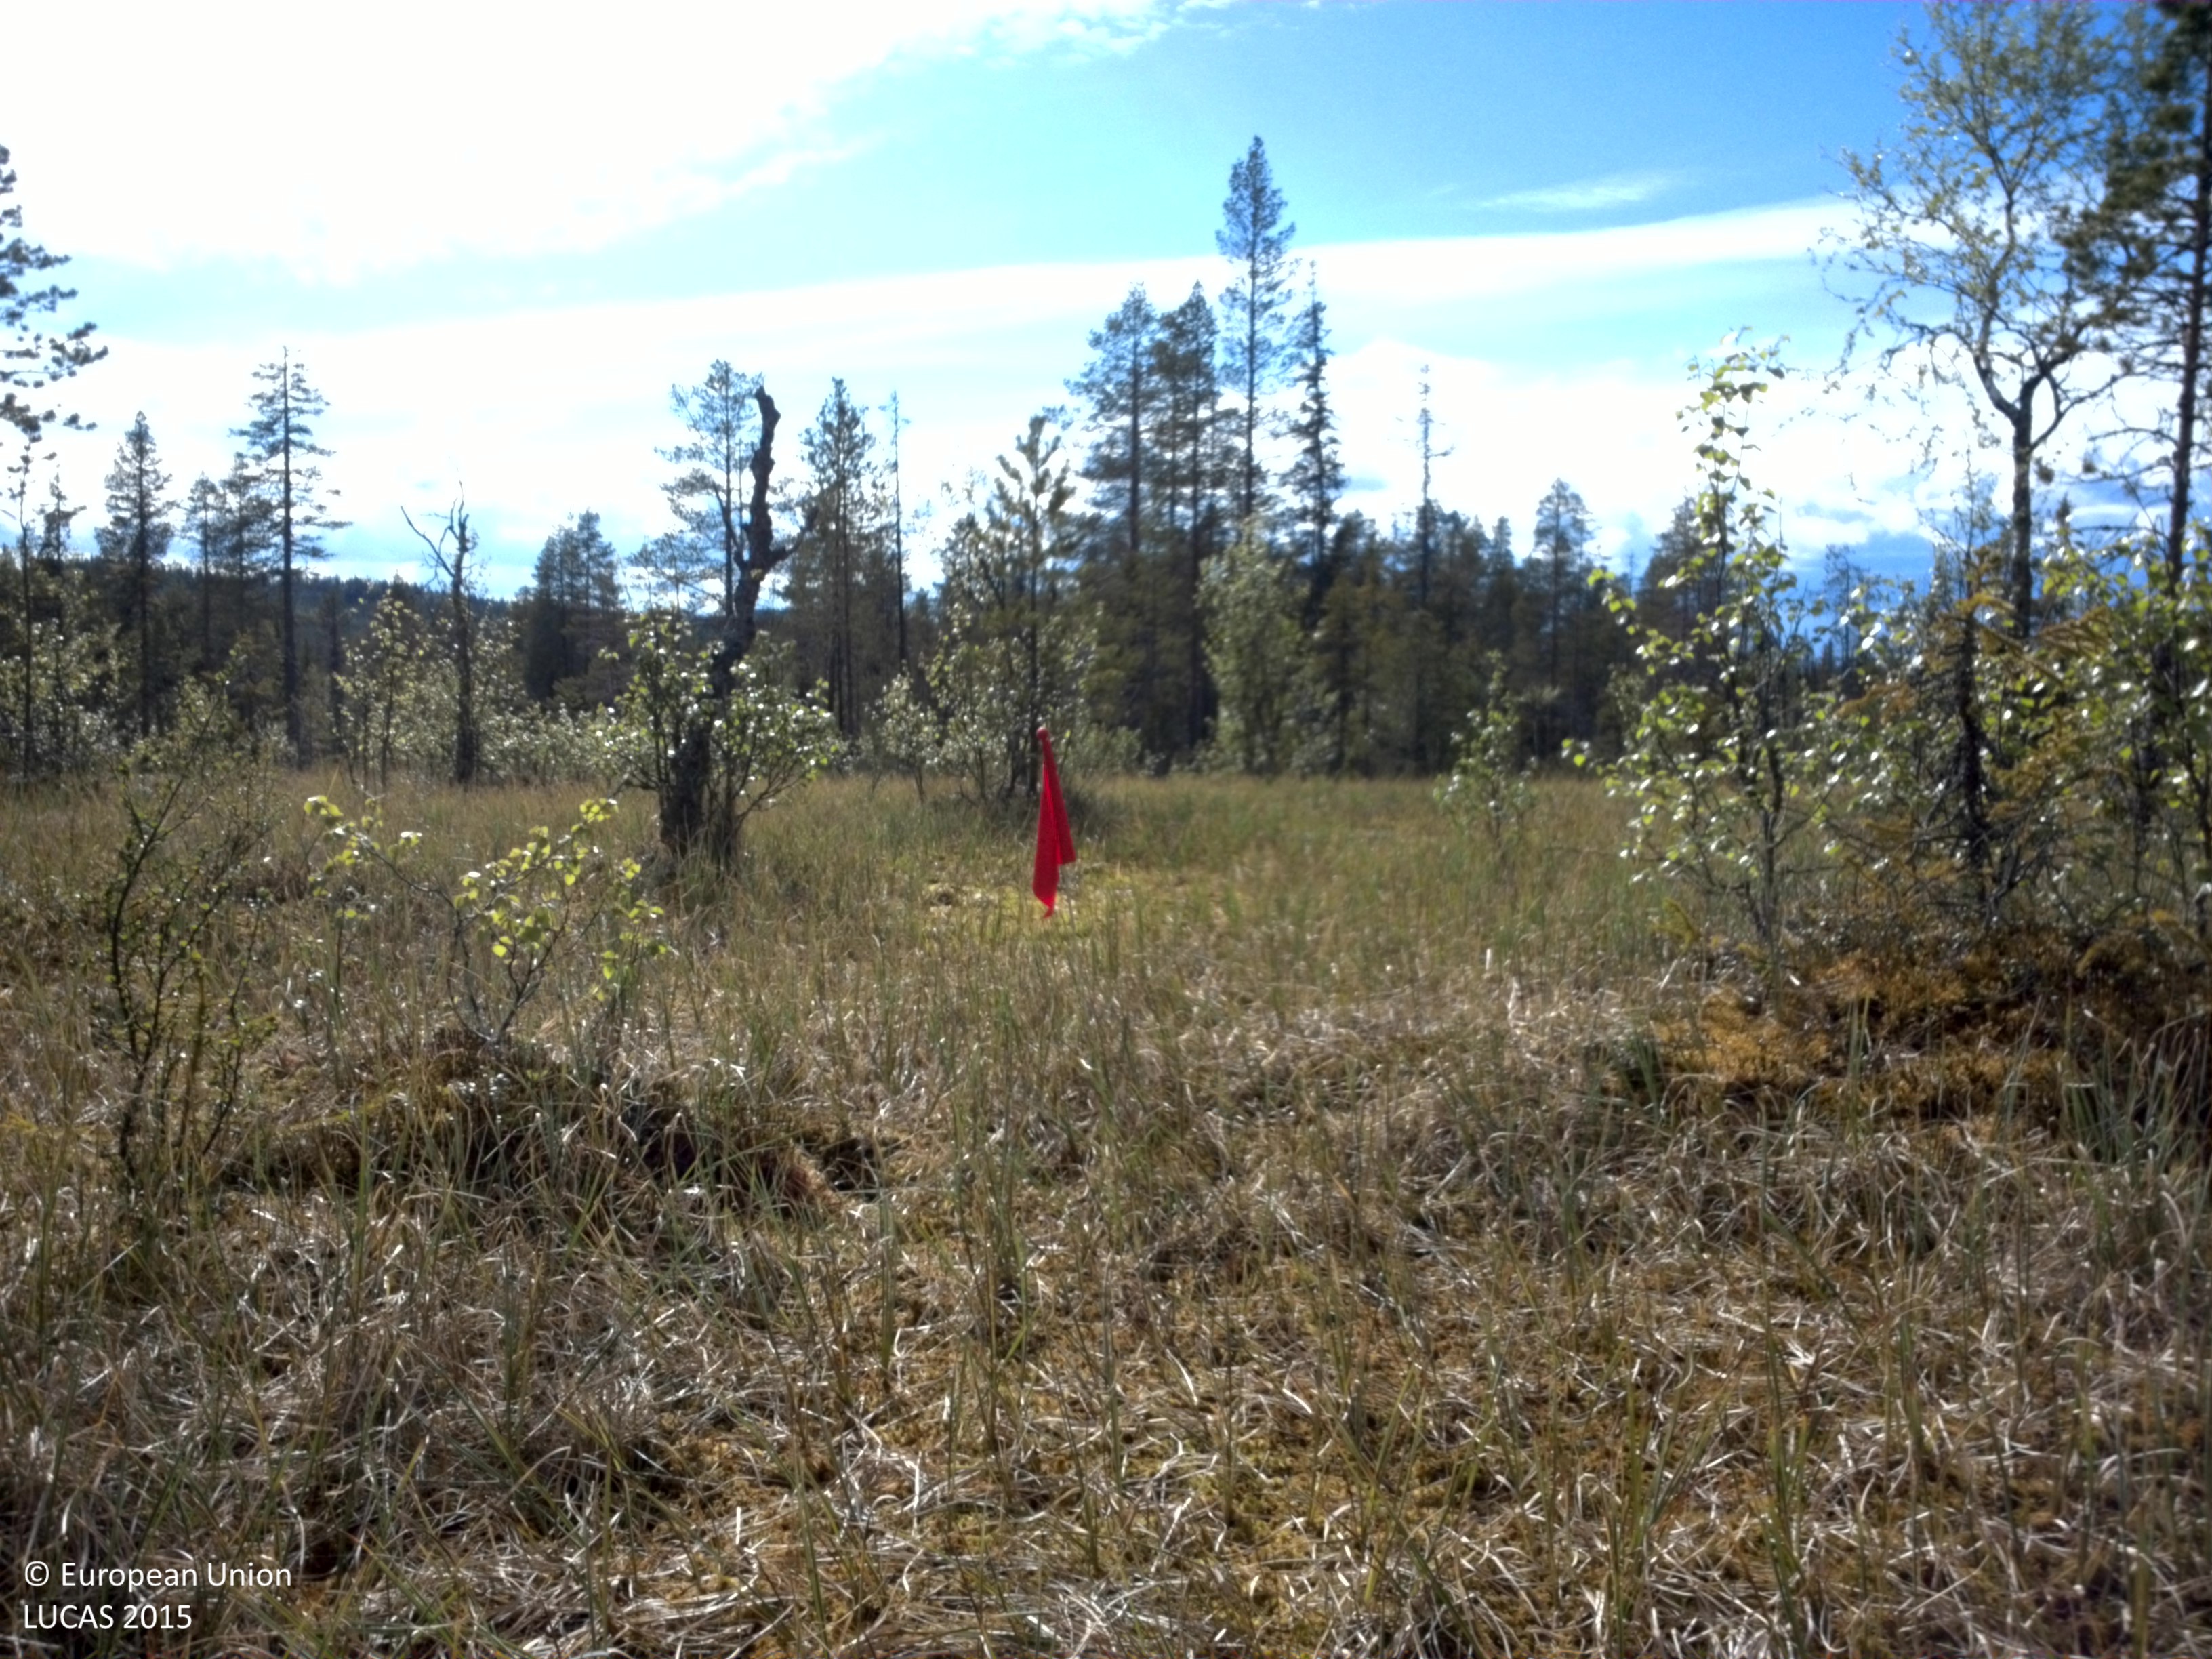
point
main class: Woodland
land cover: Pine dominated mixed woodland
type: boreal forest
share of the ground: 10 - 25 %
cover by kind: herbaceous plants 35 %, lichens and mosses 35 %, coniferous forest trees 15 %, broadleaved forest trees 10 %, shrubs 5 %
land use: Forestry
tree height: > 5 m
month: June
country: SE
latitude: 61.9352
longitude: 13.7010
